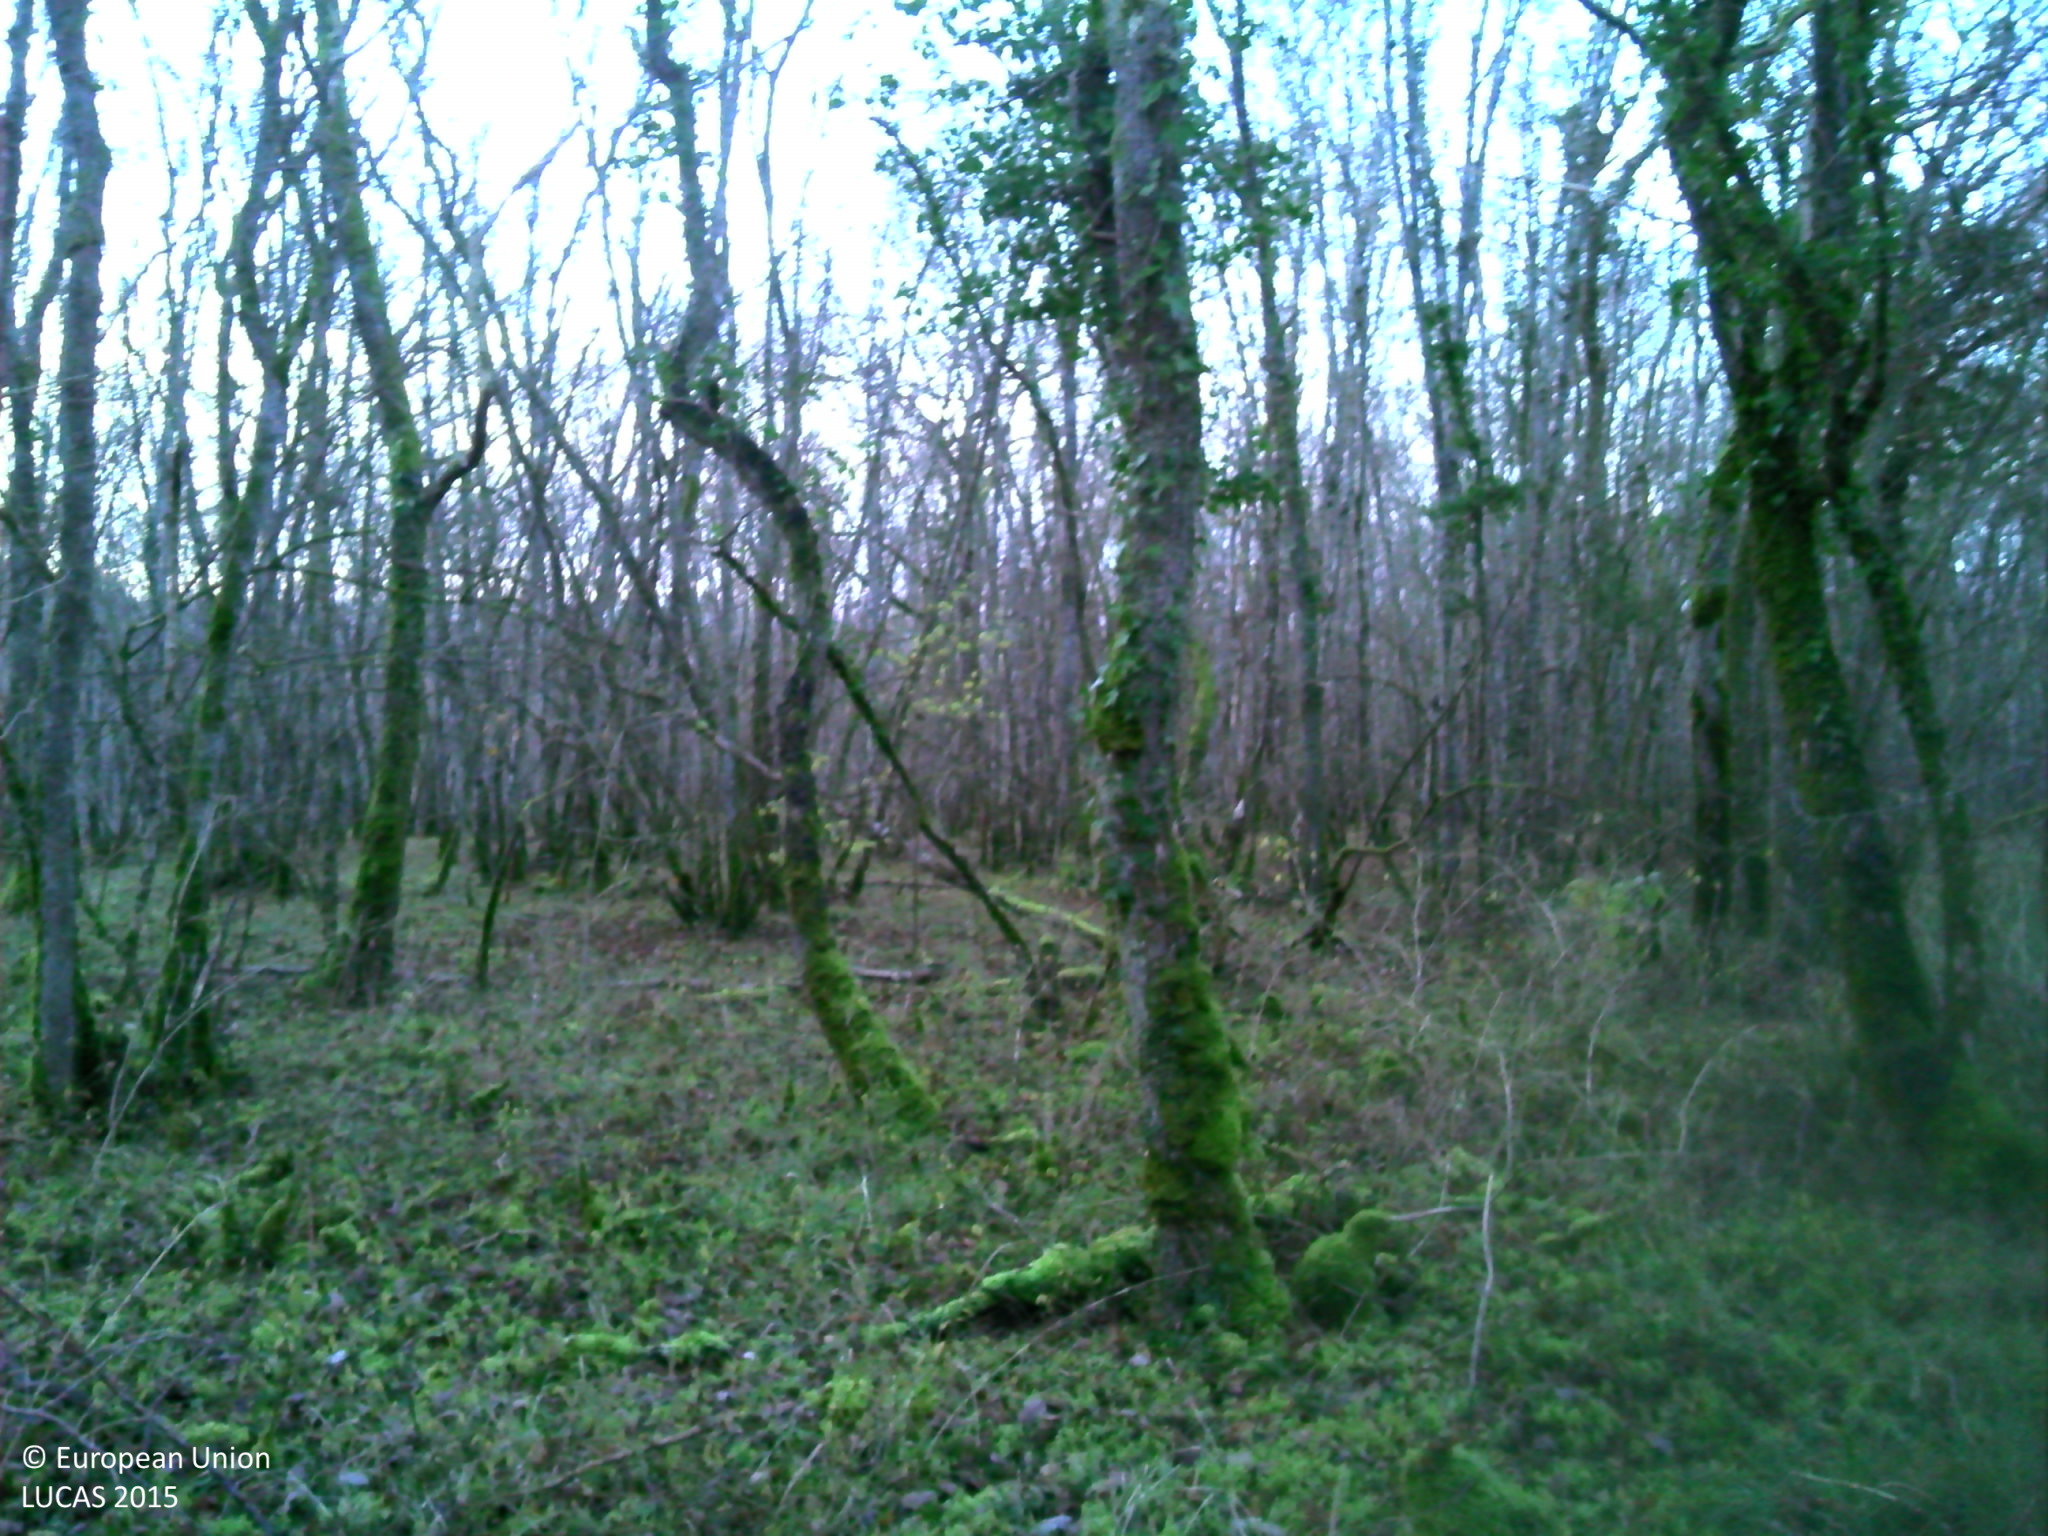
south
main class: Woodland
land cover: Broadleaved woodland
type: mesophytic deciduous forest
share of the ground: > 75 %
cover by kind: broadleaved forest trees 100 %
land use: Forestry
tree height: > 5 m
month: December
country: FR
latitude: 47.3829
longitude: 3.5193
